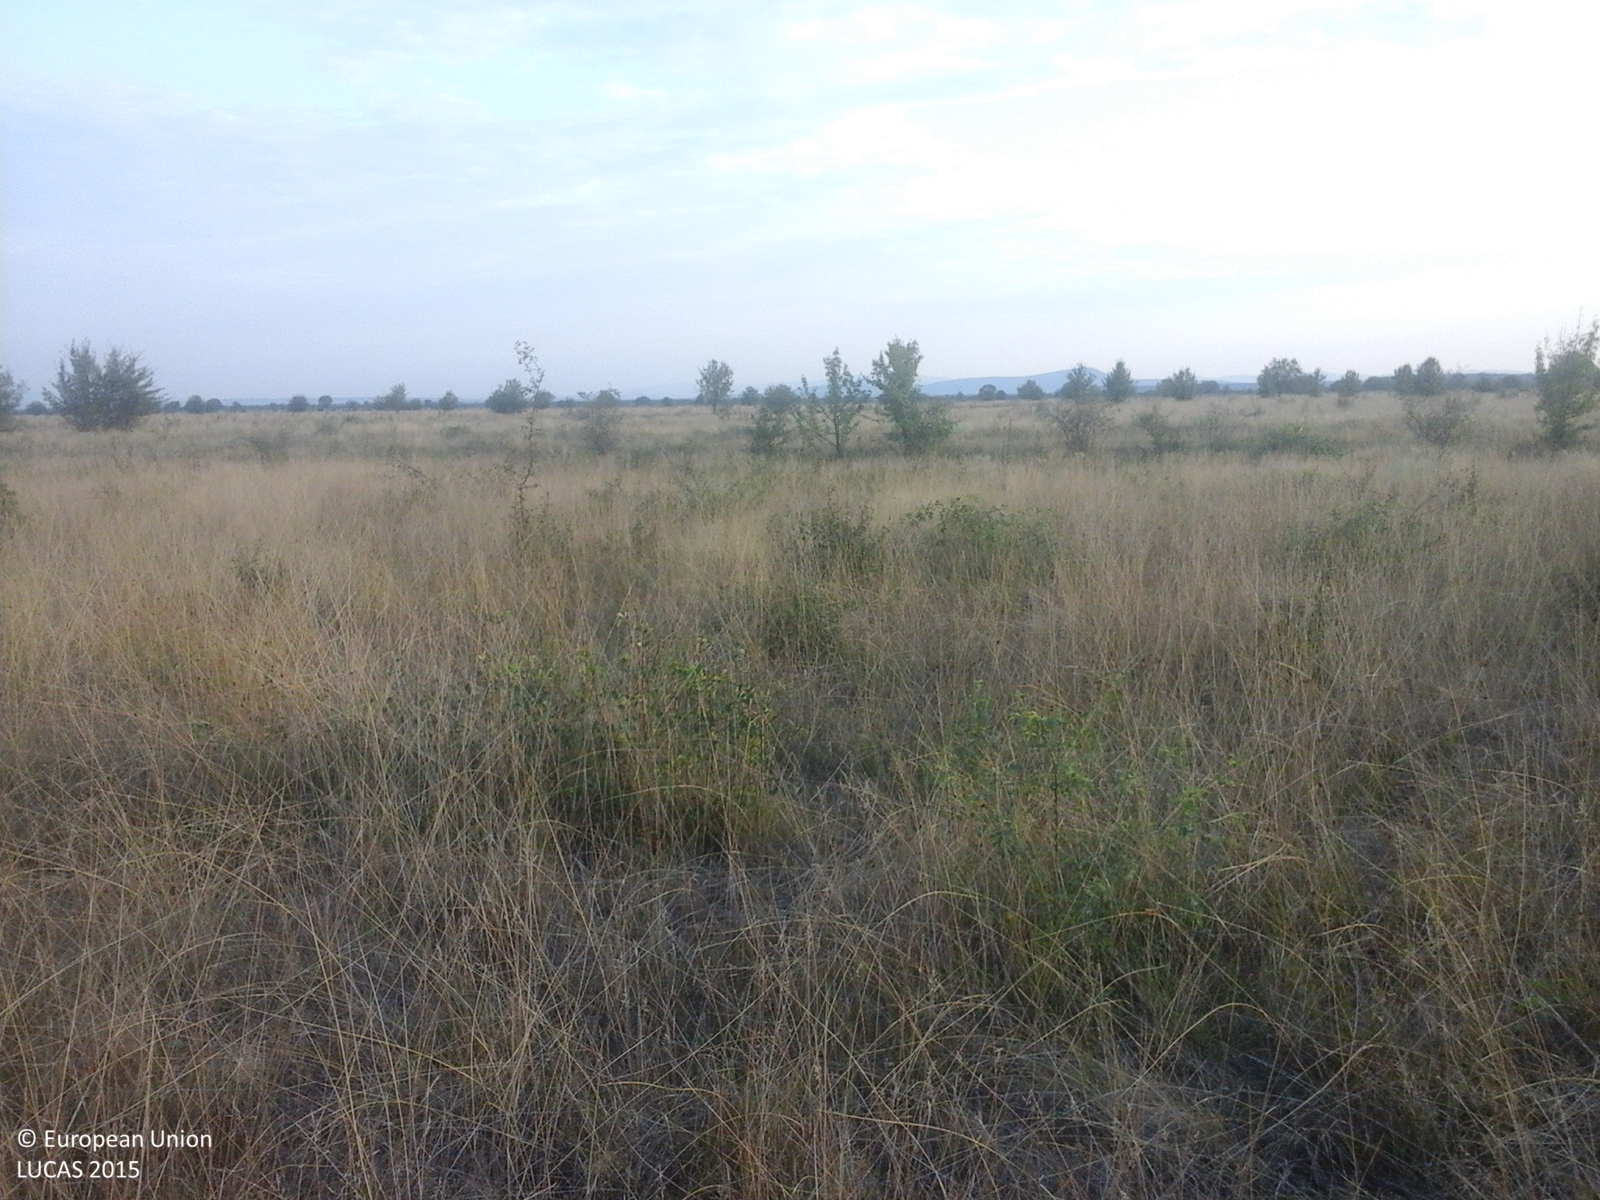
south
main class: Grassland
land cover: Grassland with sparse tree/shrub cover
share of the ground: > 75 %
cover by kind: herbaceous plants 85 %, shrubs 10 %, broadleaved forest trees 5 %
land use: Agriculture (excluding fallow land and kitchen gardens)
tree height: < 5 m
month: August
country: RO
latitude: 46.5193
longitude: 21.9181
